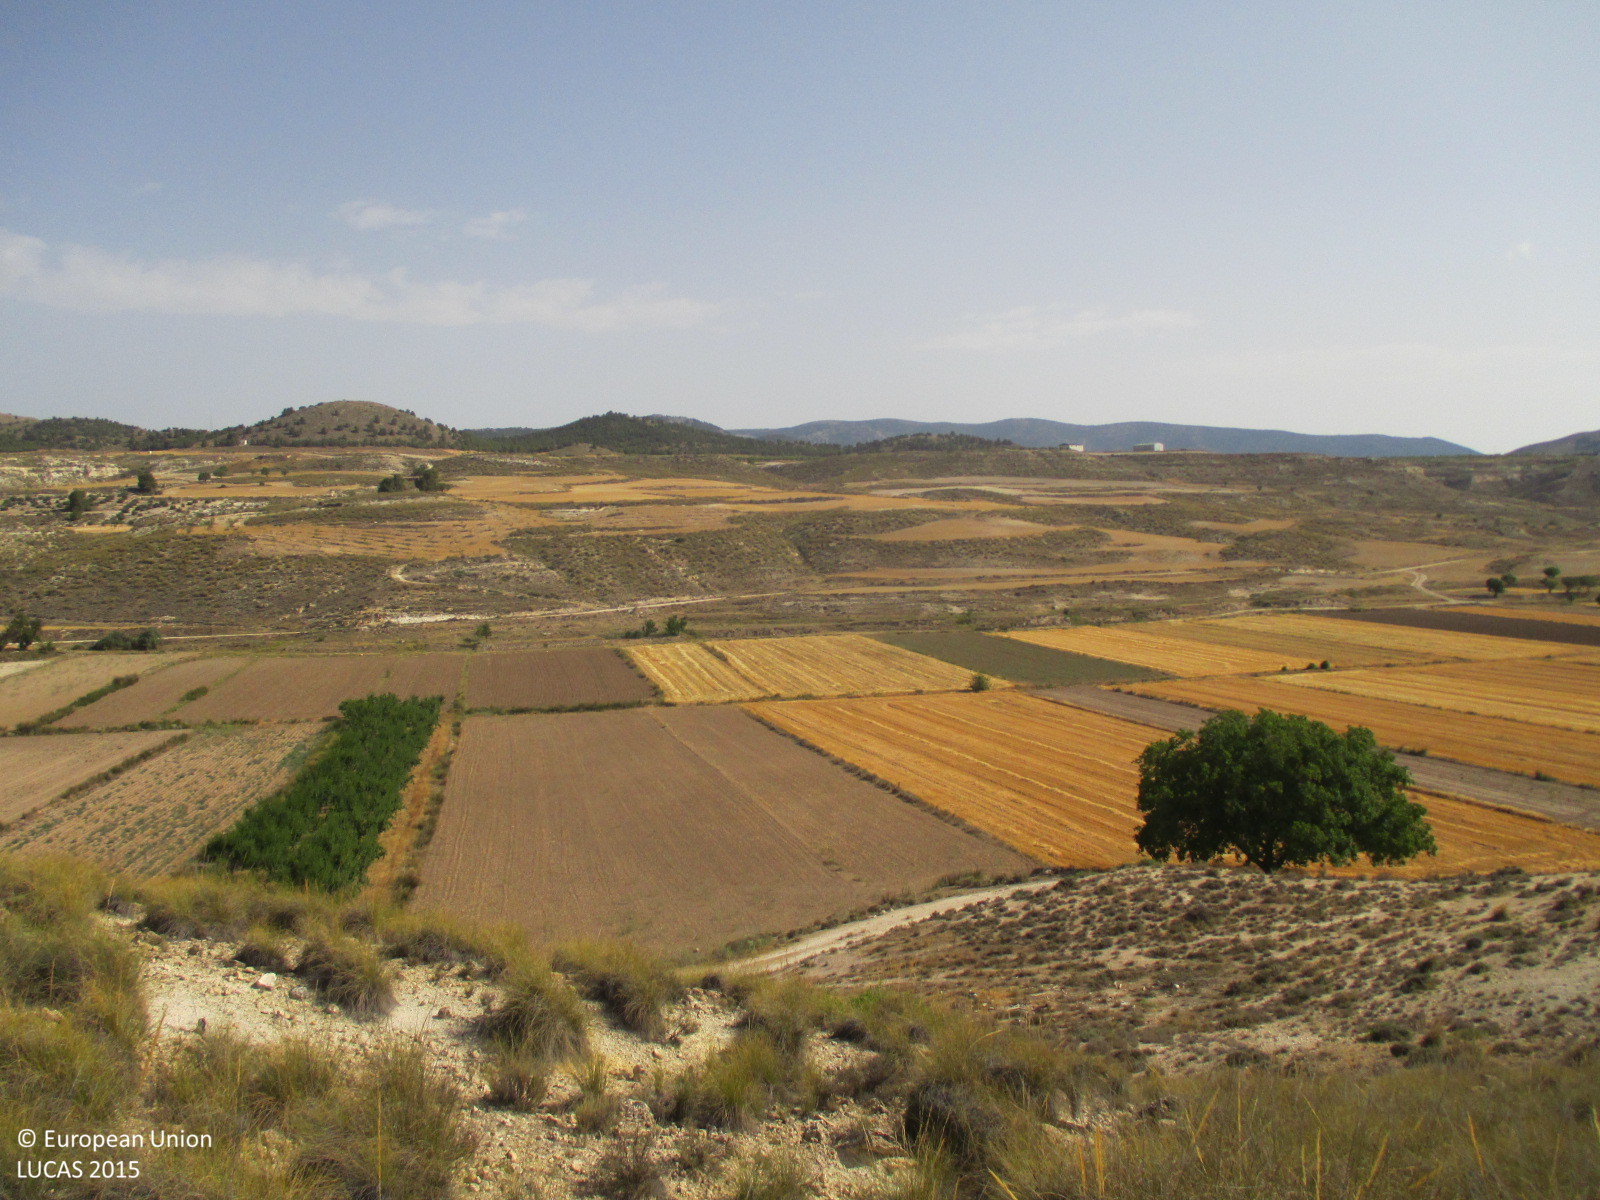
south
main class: Grassland
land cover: Grassland without tree/shrub cover
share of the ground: 50 - 75 %
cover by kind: herbaceous plants 55 %, unconsolidated bare surface 40 %, consolidated bare surface 5 %
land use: Semi-natural and natural areas not in use
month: June
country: ES
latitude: 37.7311
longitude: -2.4581
